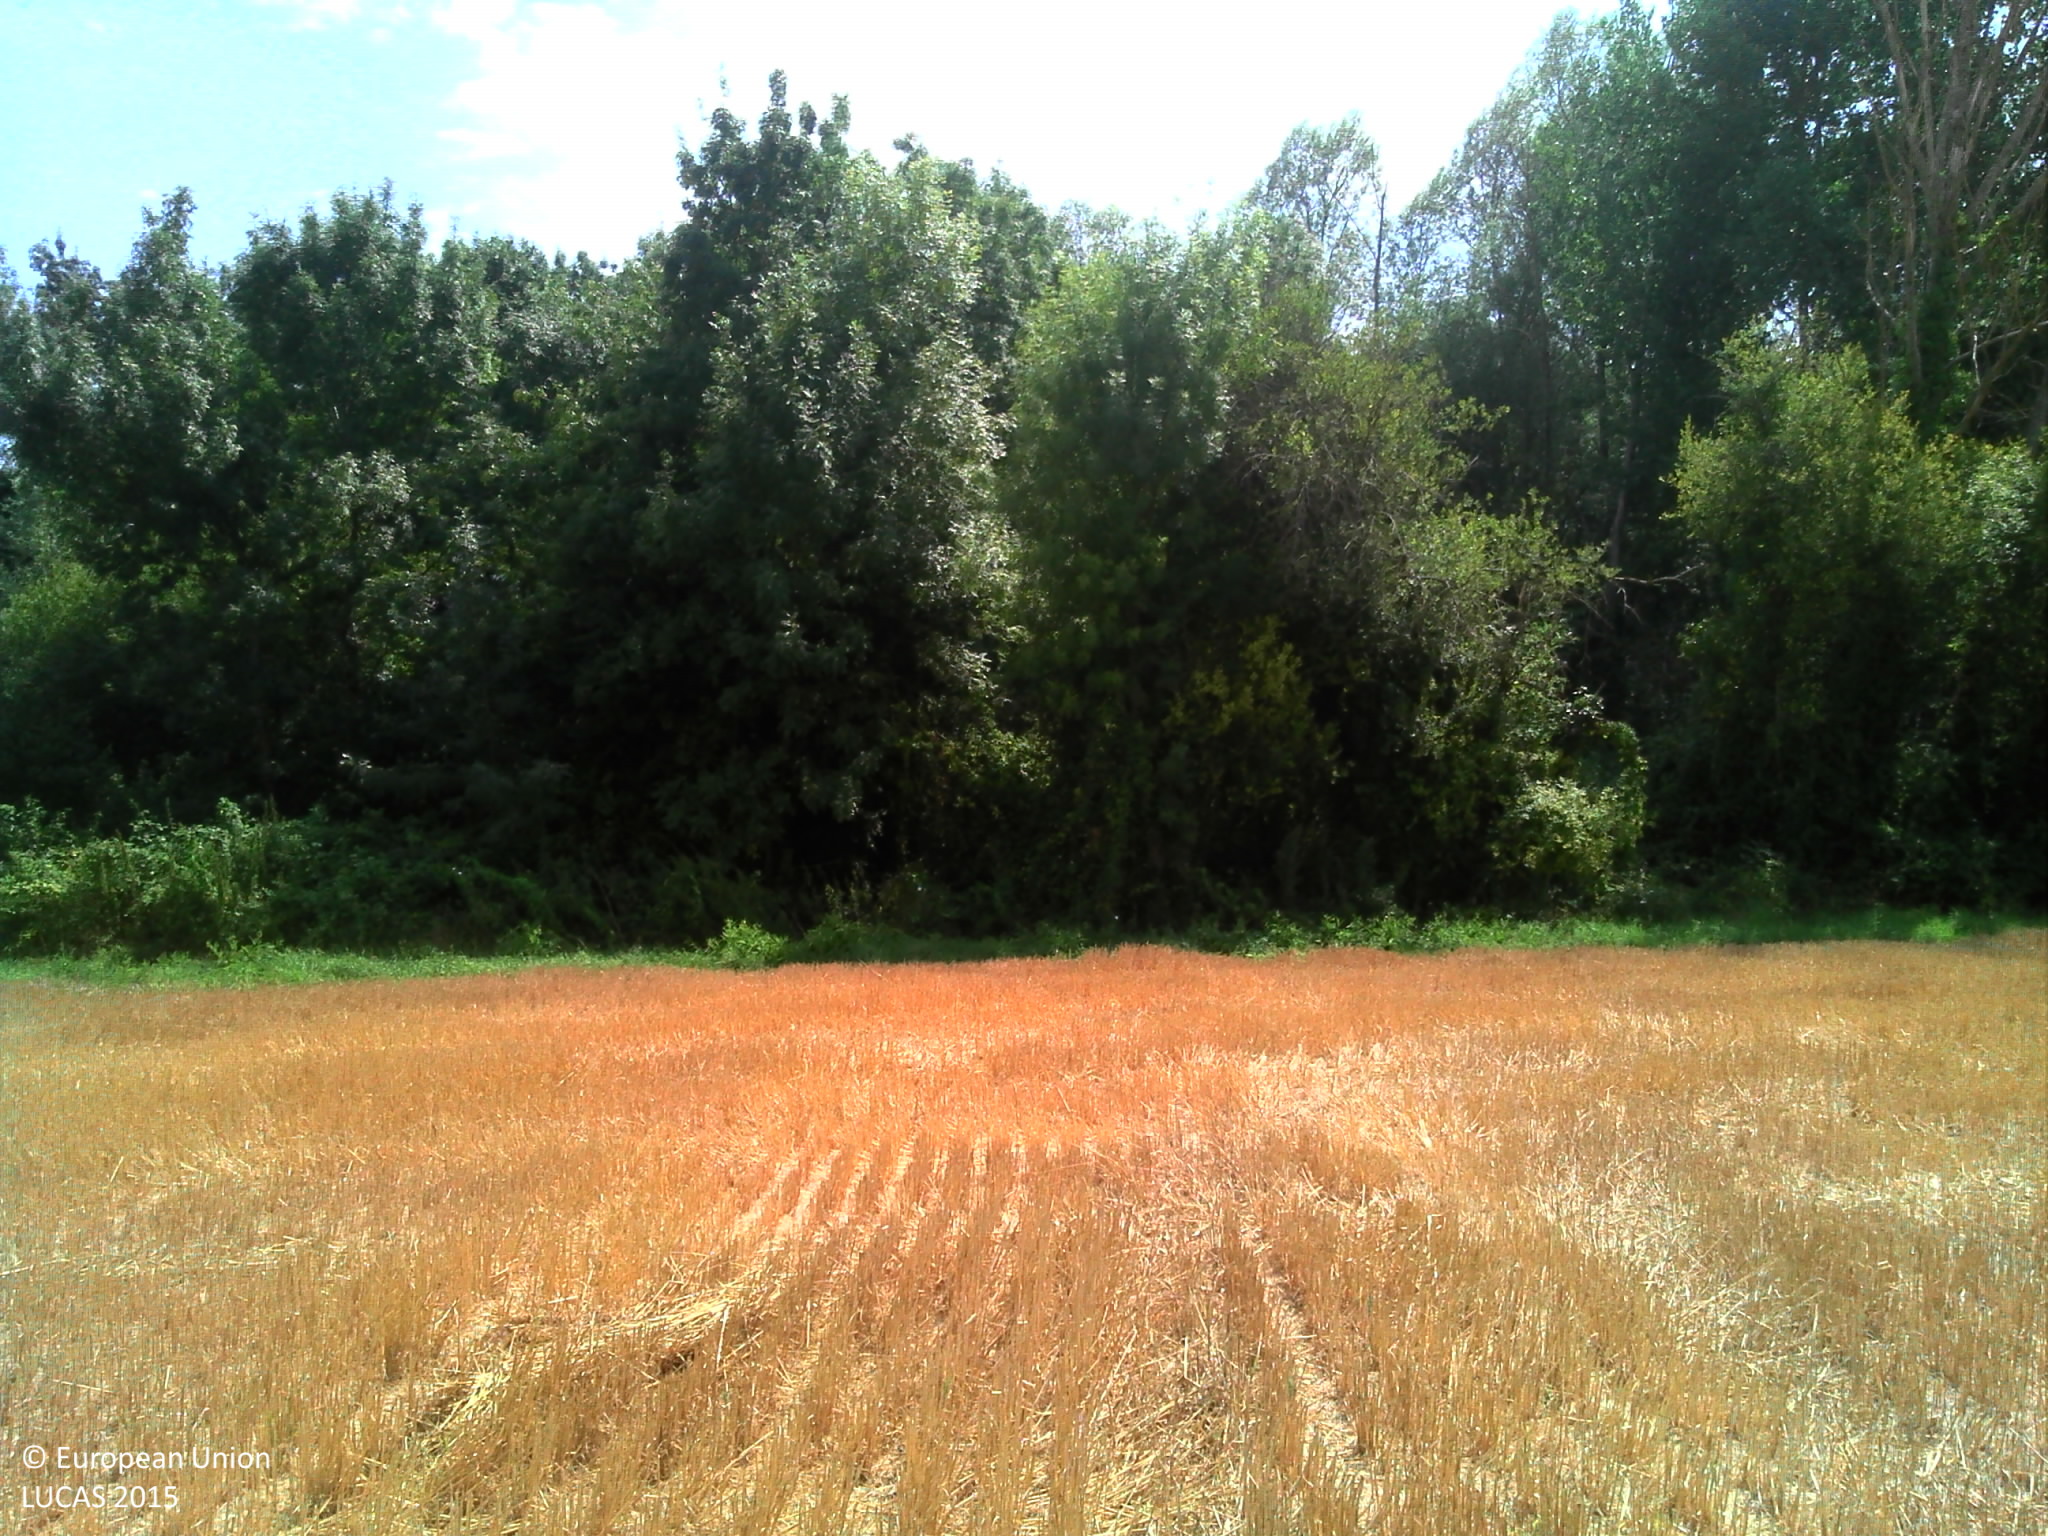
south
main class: Cropland
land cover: Common wheat
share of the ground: > 75 %
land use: Agriculture (excluding fallow land and kitchen gardens)
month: August
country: FR
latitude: 47.1293
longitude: 0.1557
